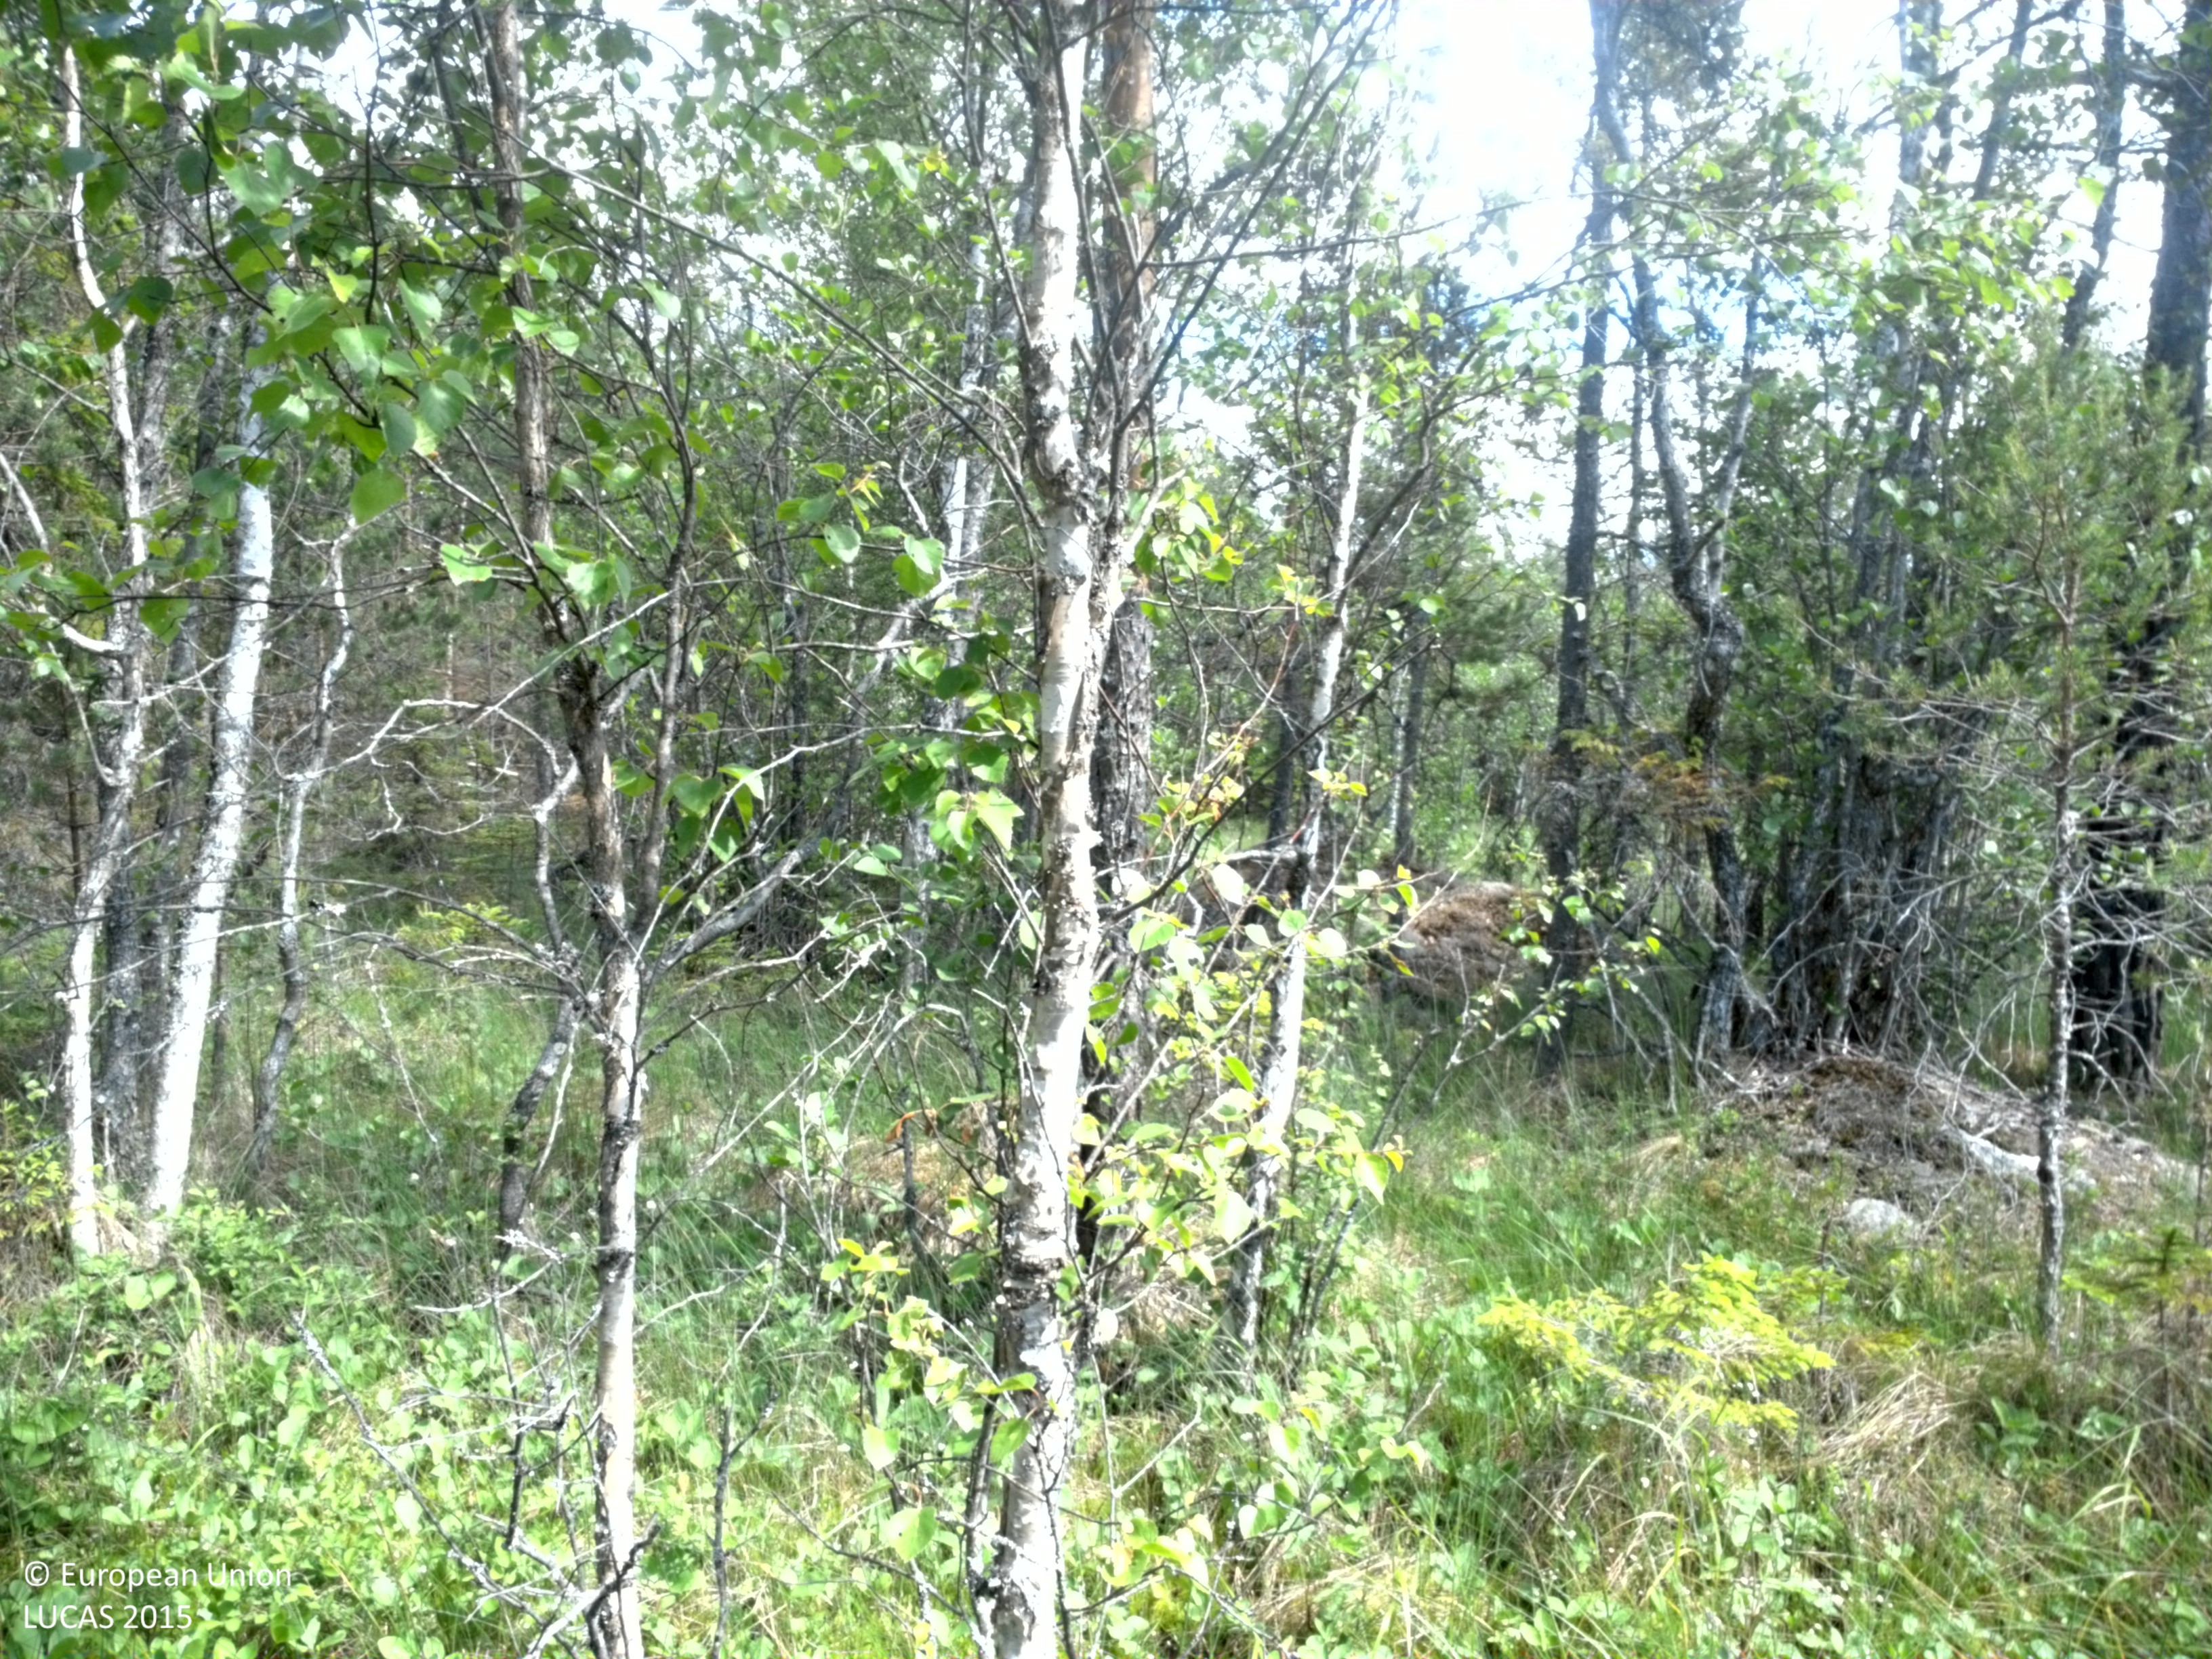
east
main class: Woodland
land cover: Pine dominated mixed woodland
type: boreal forest
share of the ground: 25 - 50 %
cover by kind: lichens and mosses 50 %, coniferous forest trees 30 %, broadleaved forest trees 10 %, herbaceous plants 10 %
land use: Forestry
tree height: > 5 m
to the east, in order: Pine dominated mixed woodland; Pine dominated coniferous woodland; Other coniferous woodland; Pine dominated coniferous woodland; Other coniferous woodland; Pine dominated coniferous woodland
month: July
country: SE
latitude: 60.0066
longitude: 17.0038
